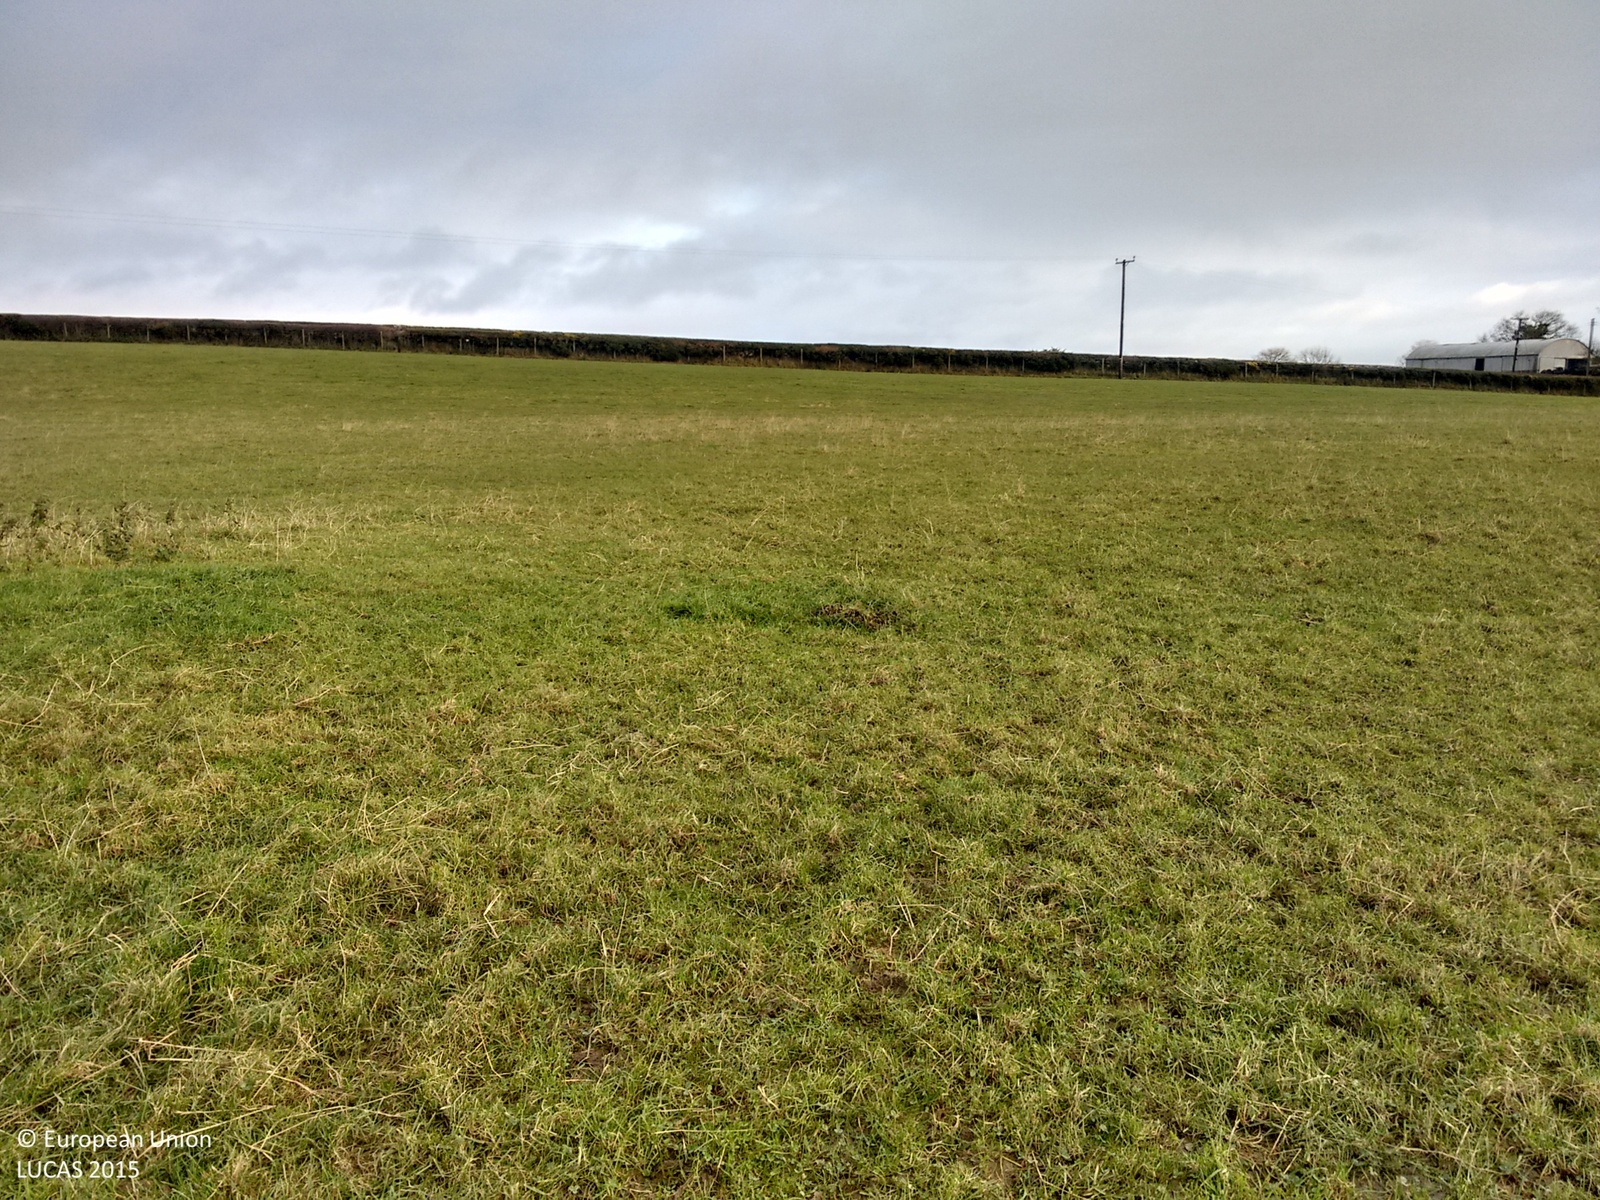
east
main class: Grassland
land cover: Grassland without tree/shrub cover
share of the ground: > 75 %
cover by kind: herbaceous plants 100 %
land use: Agriculture (excluding fallow land and kitchen gardens)
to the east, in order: Grassland without tree/shrub cover; Electric lines; Fences; Managed hedges; Grass margins; Tracks; Grass margins; Managed hedges; Fences; Grassland without tree/shrub cover
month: November
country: GB
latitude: 54.6542
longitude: -5.6143
